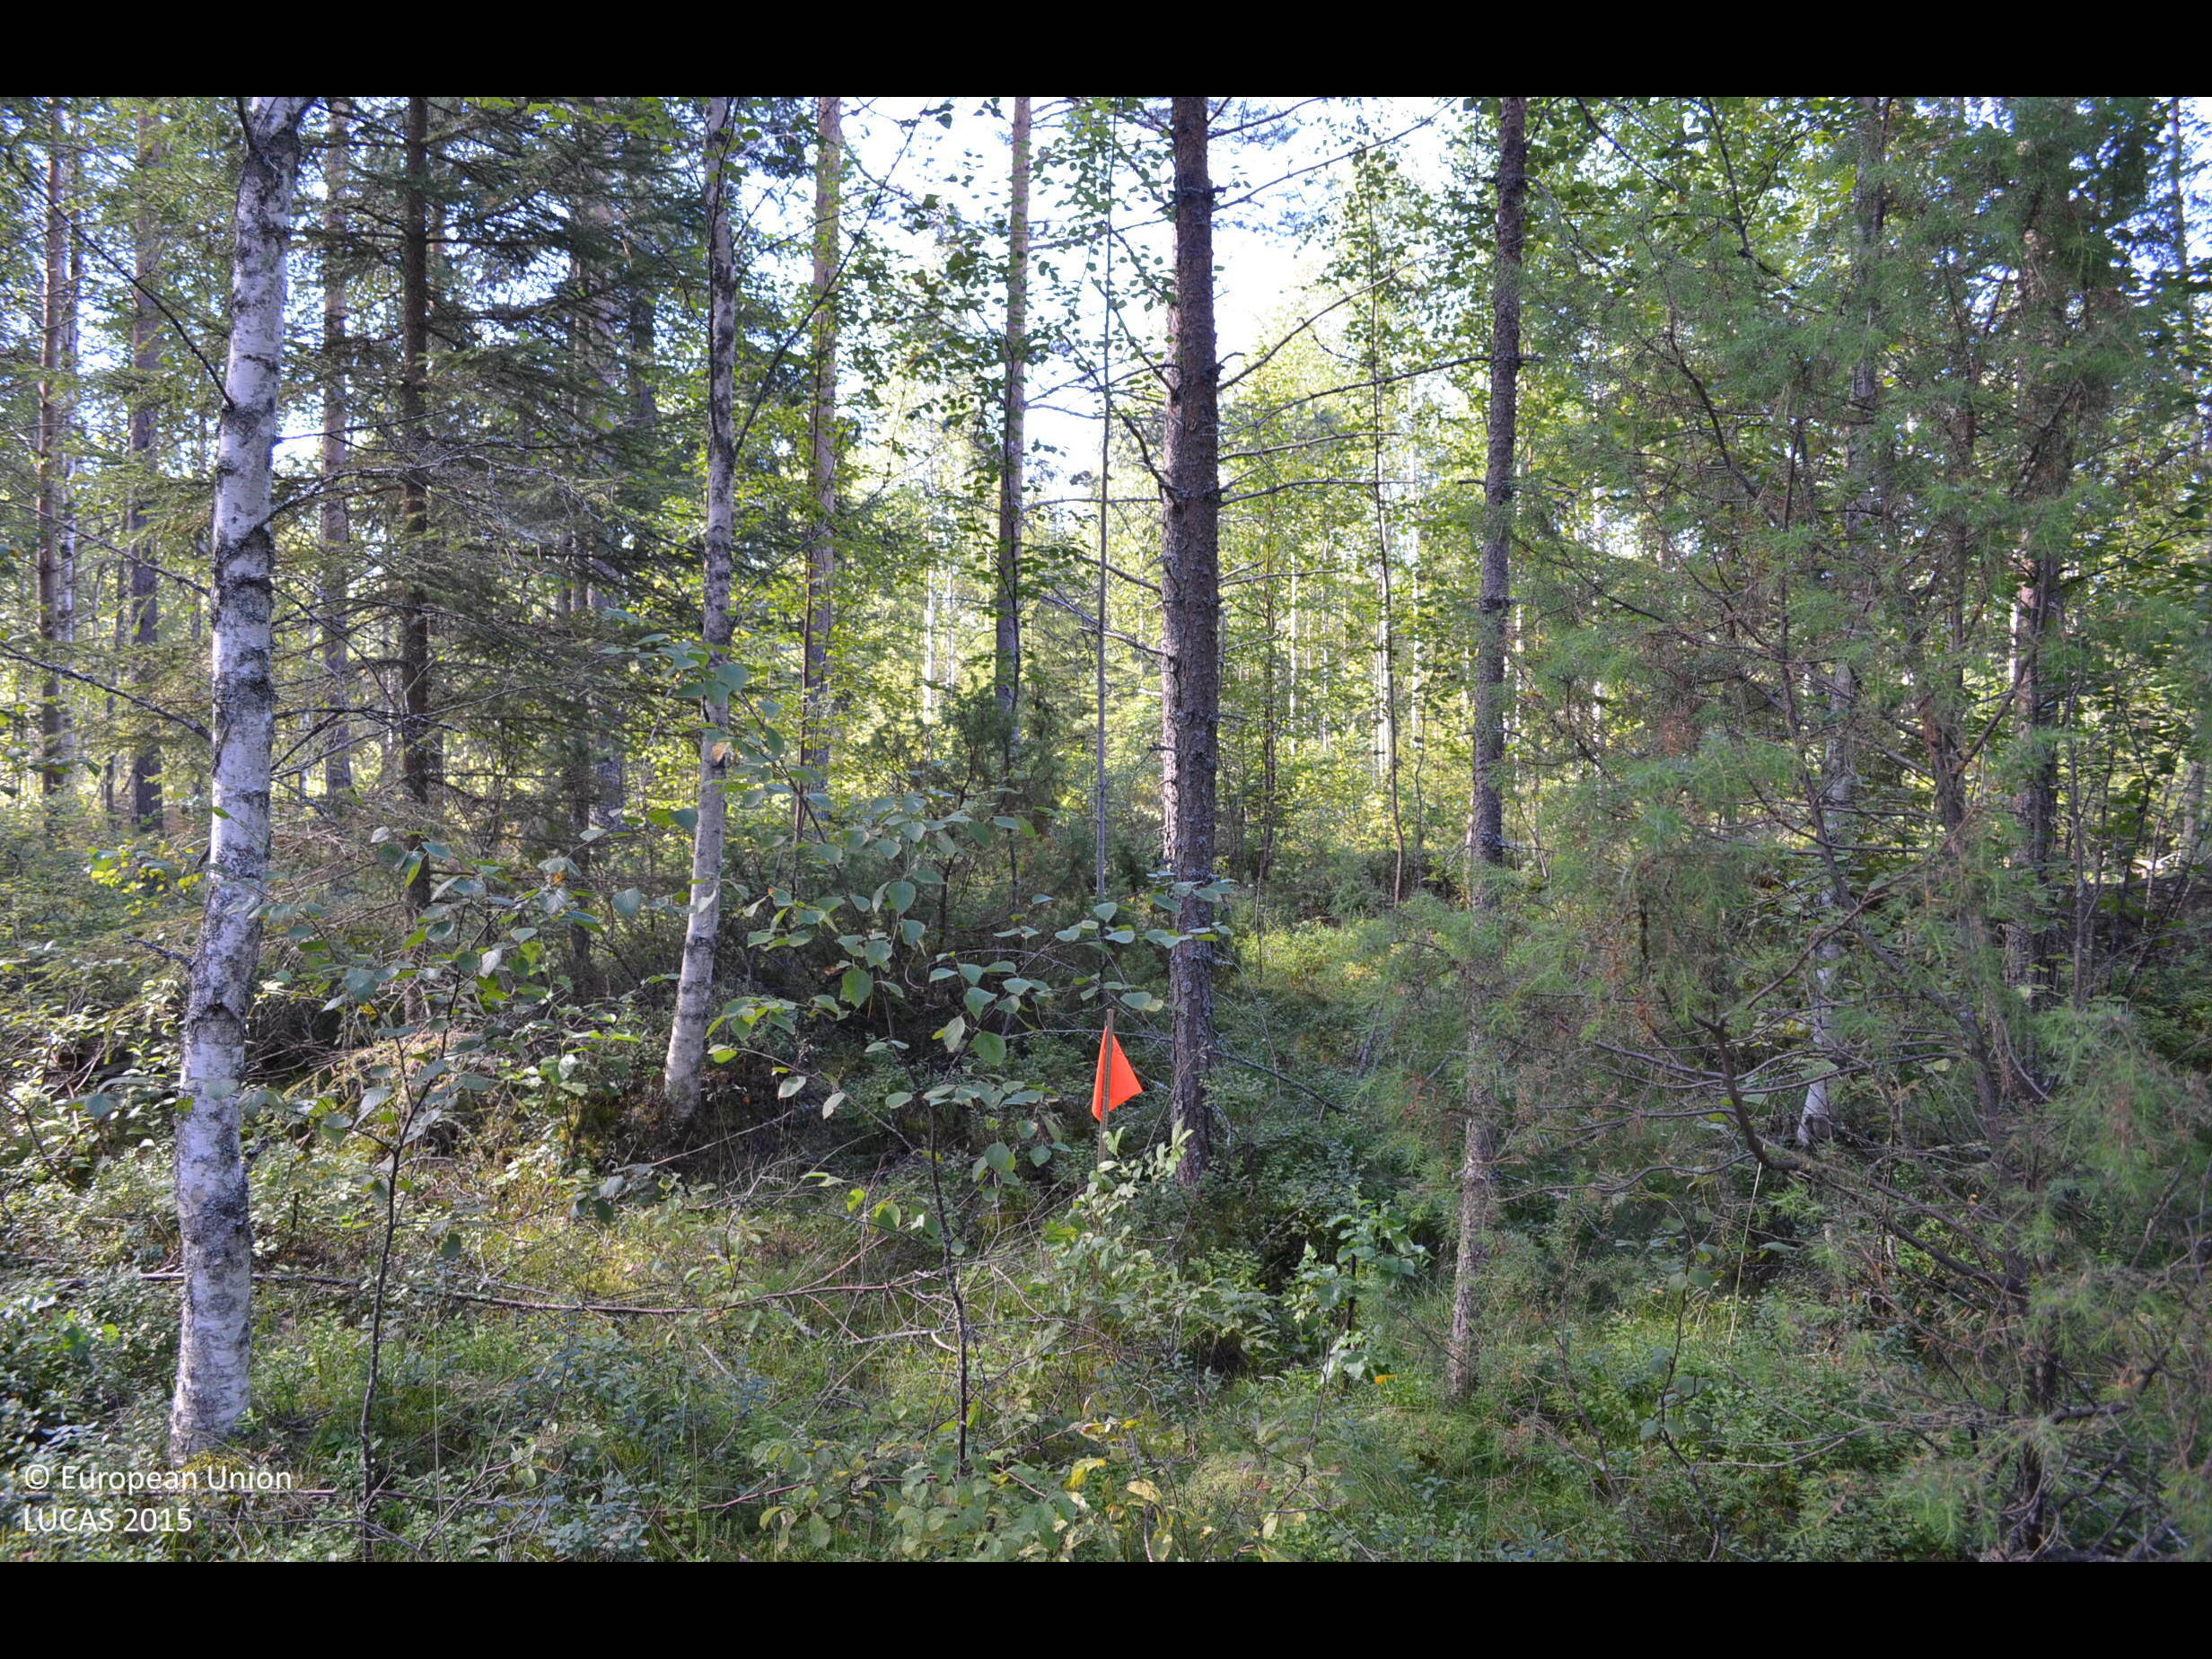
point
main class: Woodland
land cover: Pine dominated mixed woodland
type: boreal forest
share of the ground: > 75 %
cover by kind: coniferous forest trees 50 %, broadleaved forest trees 35 %, shrubs 15 %
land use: Forestry
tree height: > 5 m
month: August
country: FI
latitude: 62.2504
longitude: 24.3547
